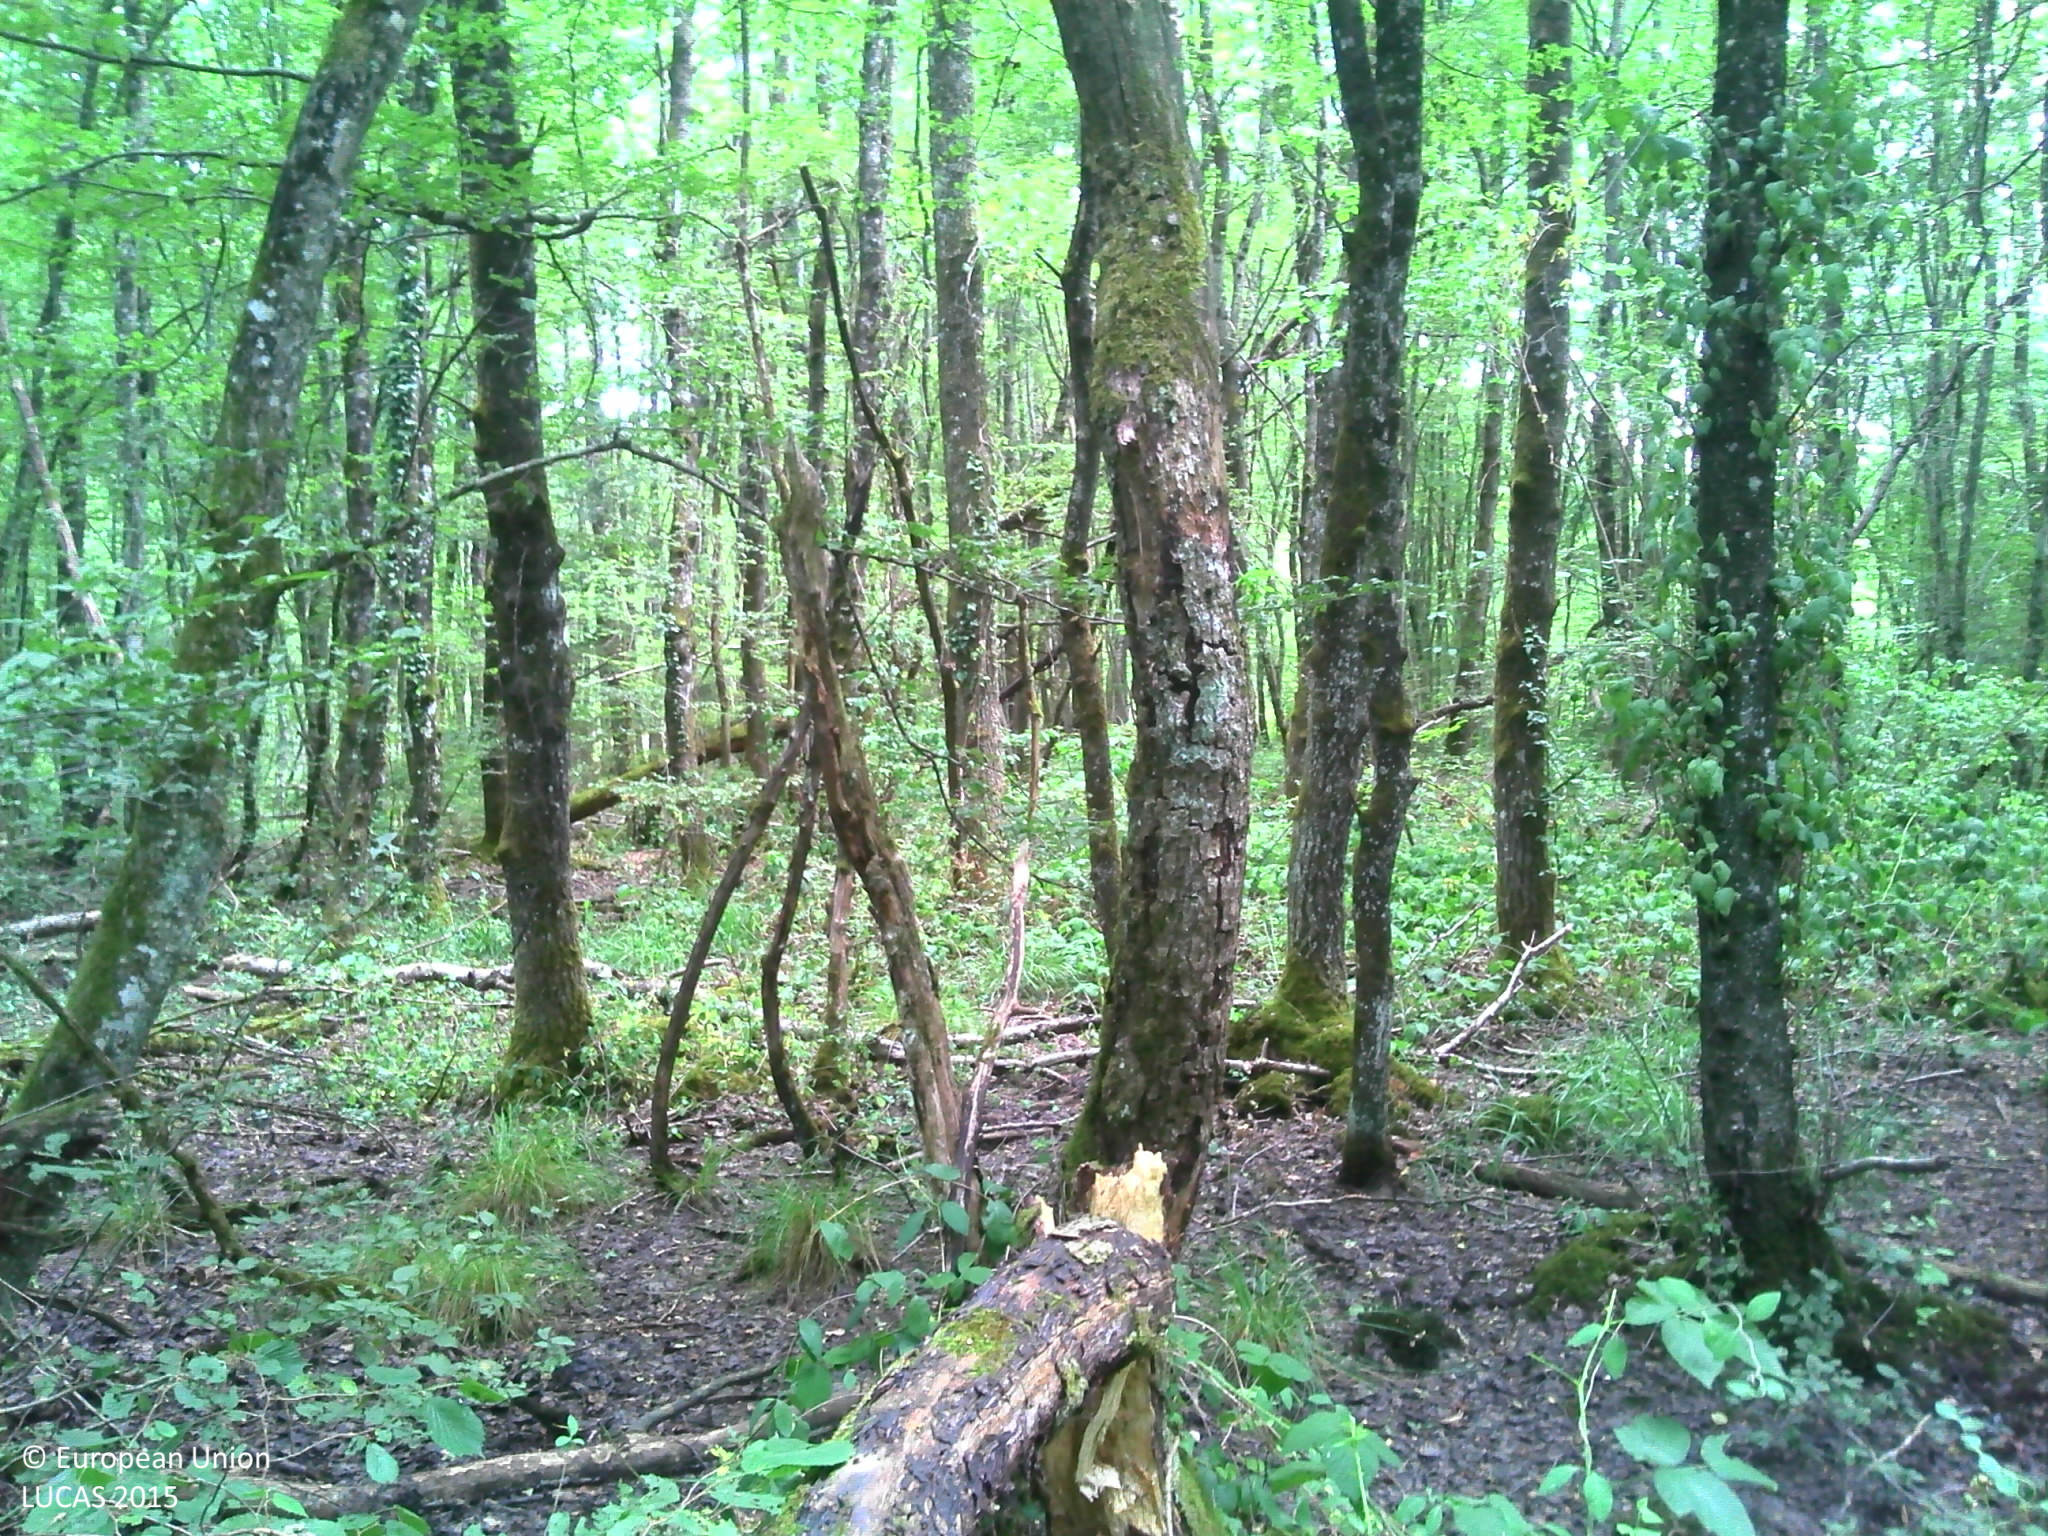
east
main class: Woodland
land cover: Broadleaved woodland
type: beech forest
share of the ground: > 75 %
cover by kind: broadleaved forest trees 70 %, herbaceous plants 25 %, lichens and mosses 5 %
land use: Forestry
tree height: > 5 m
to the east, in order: Broadleaved woodland; Tracks; Broadleaved woodland
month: July
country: FR
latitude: 46.3413
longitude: 6.3004
